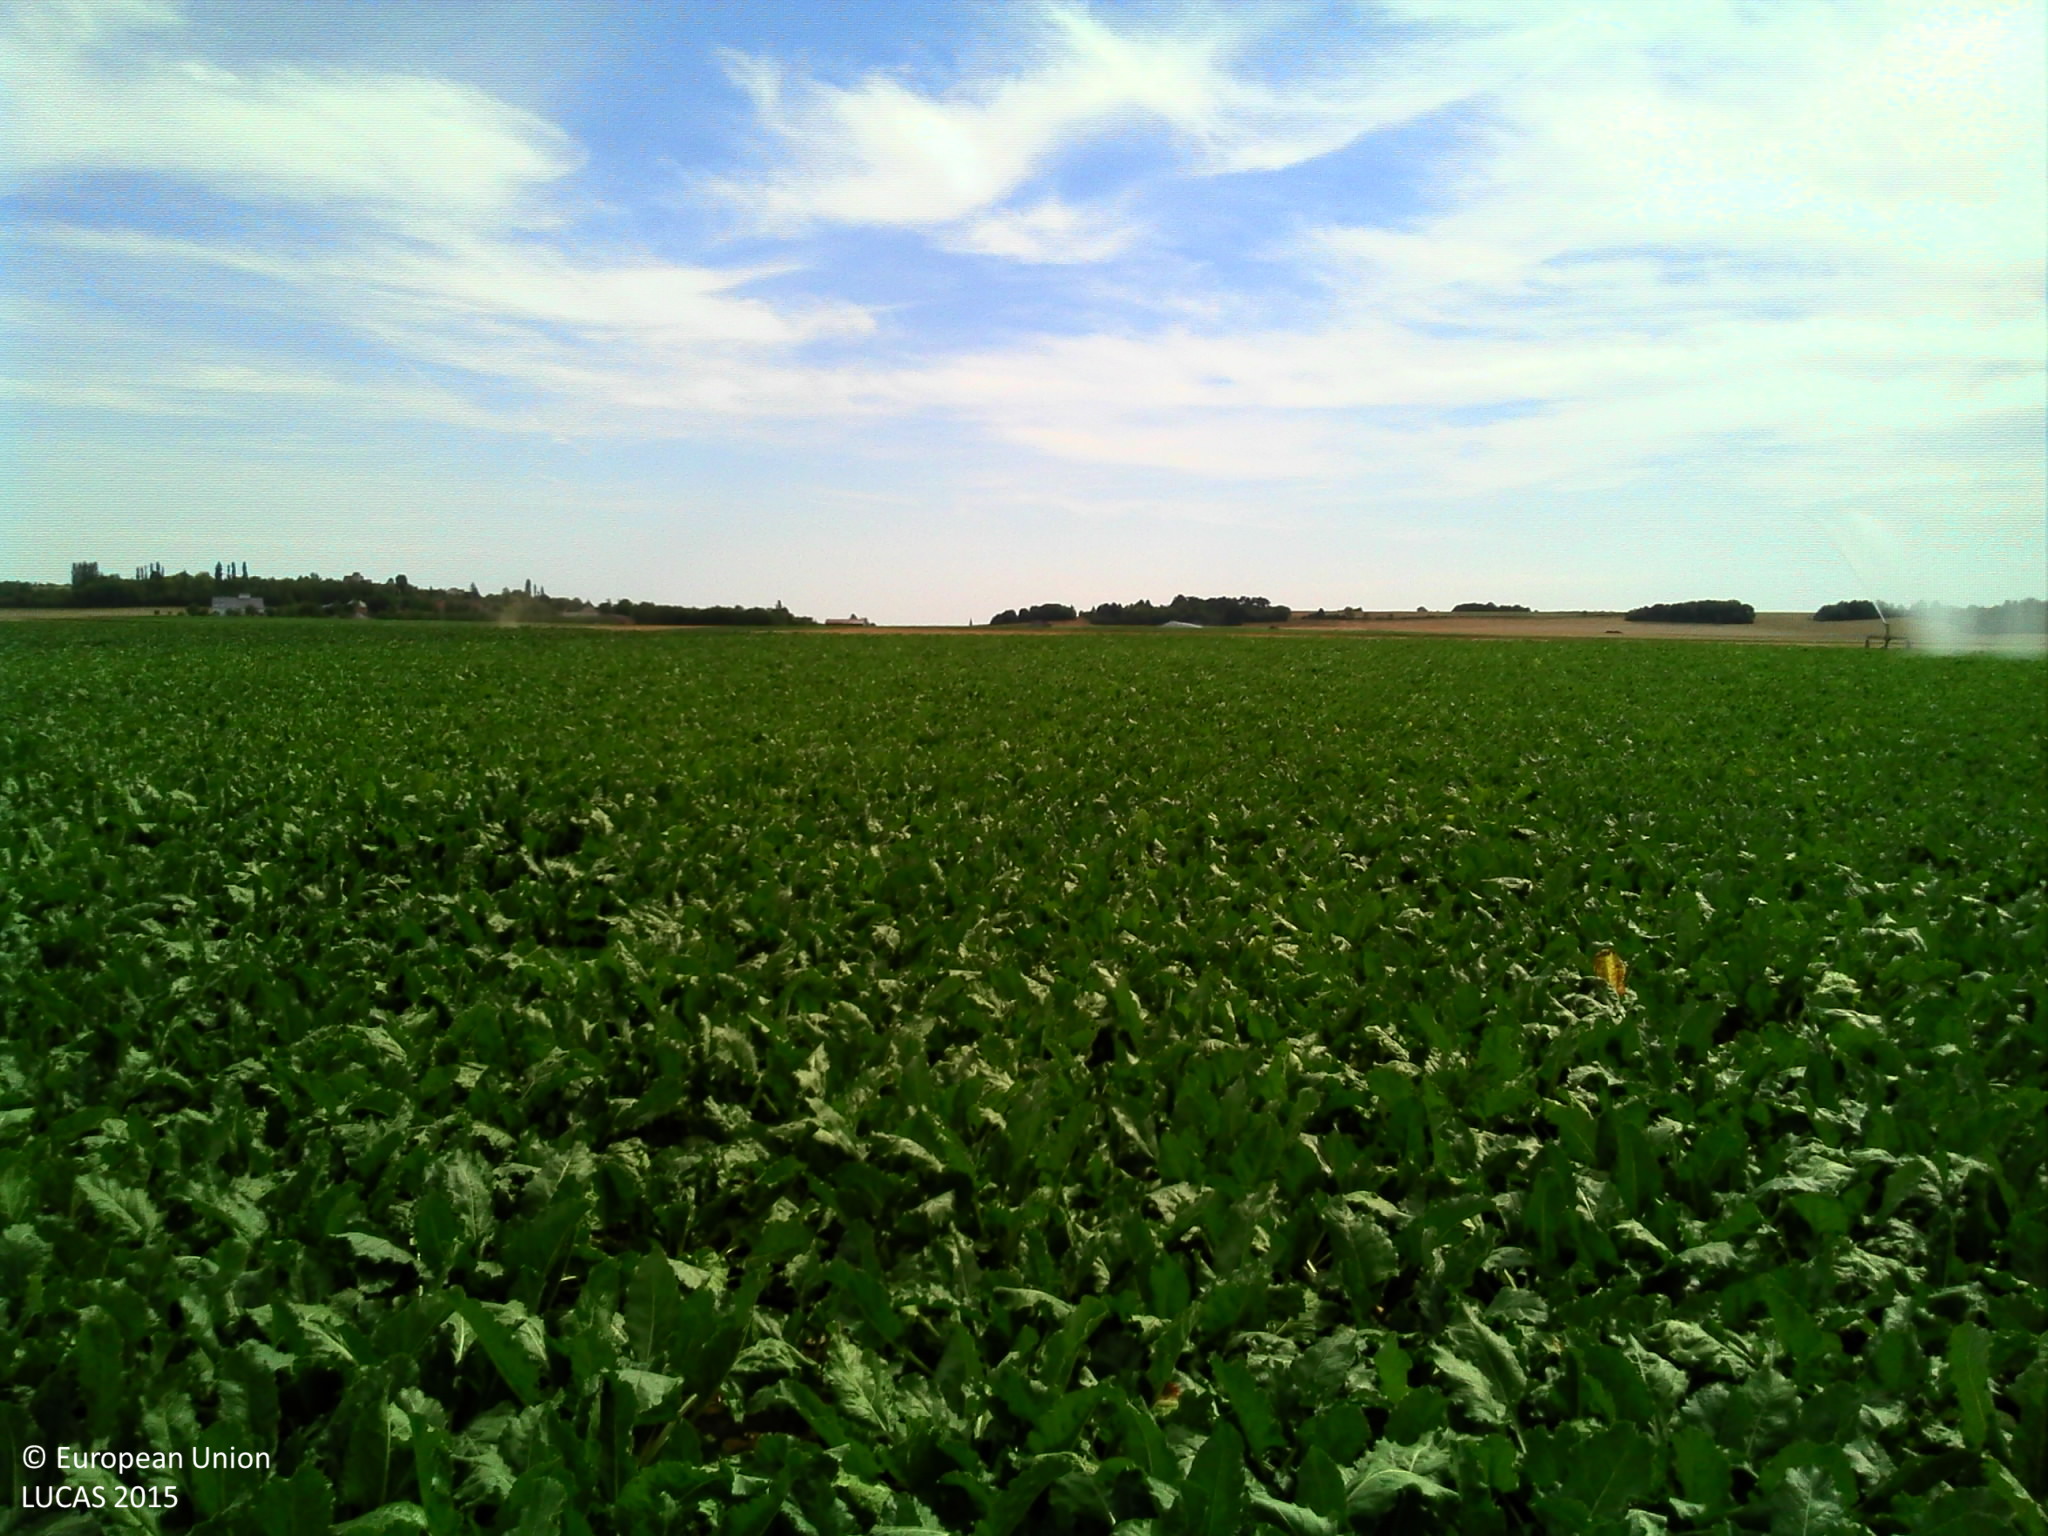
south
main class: Cropland
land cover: Sugar beet
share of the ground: > 75 %
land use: Agriculture (excluding fallow land and kitchen gardens)
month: August
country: FR
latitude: 48.2383
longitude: 2.4901
